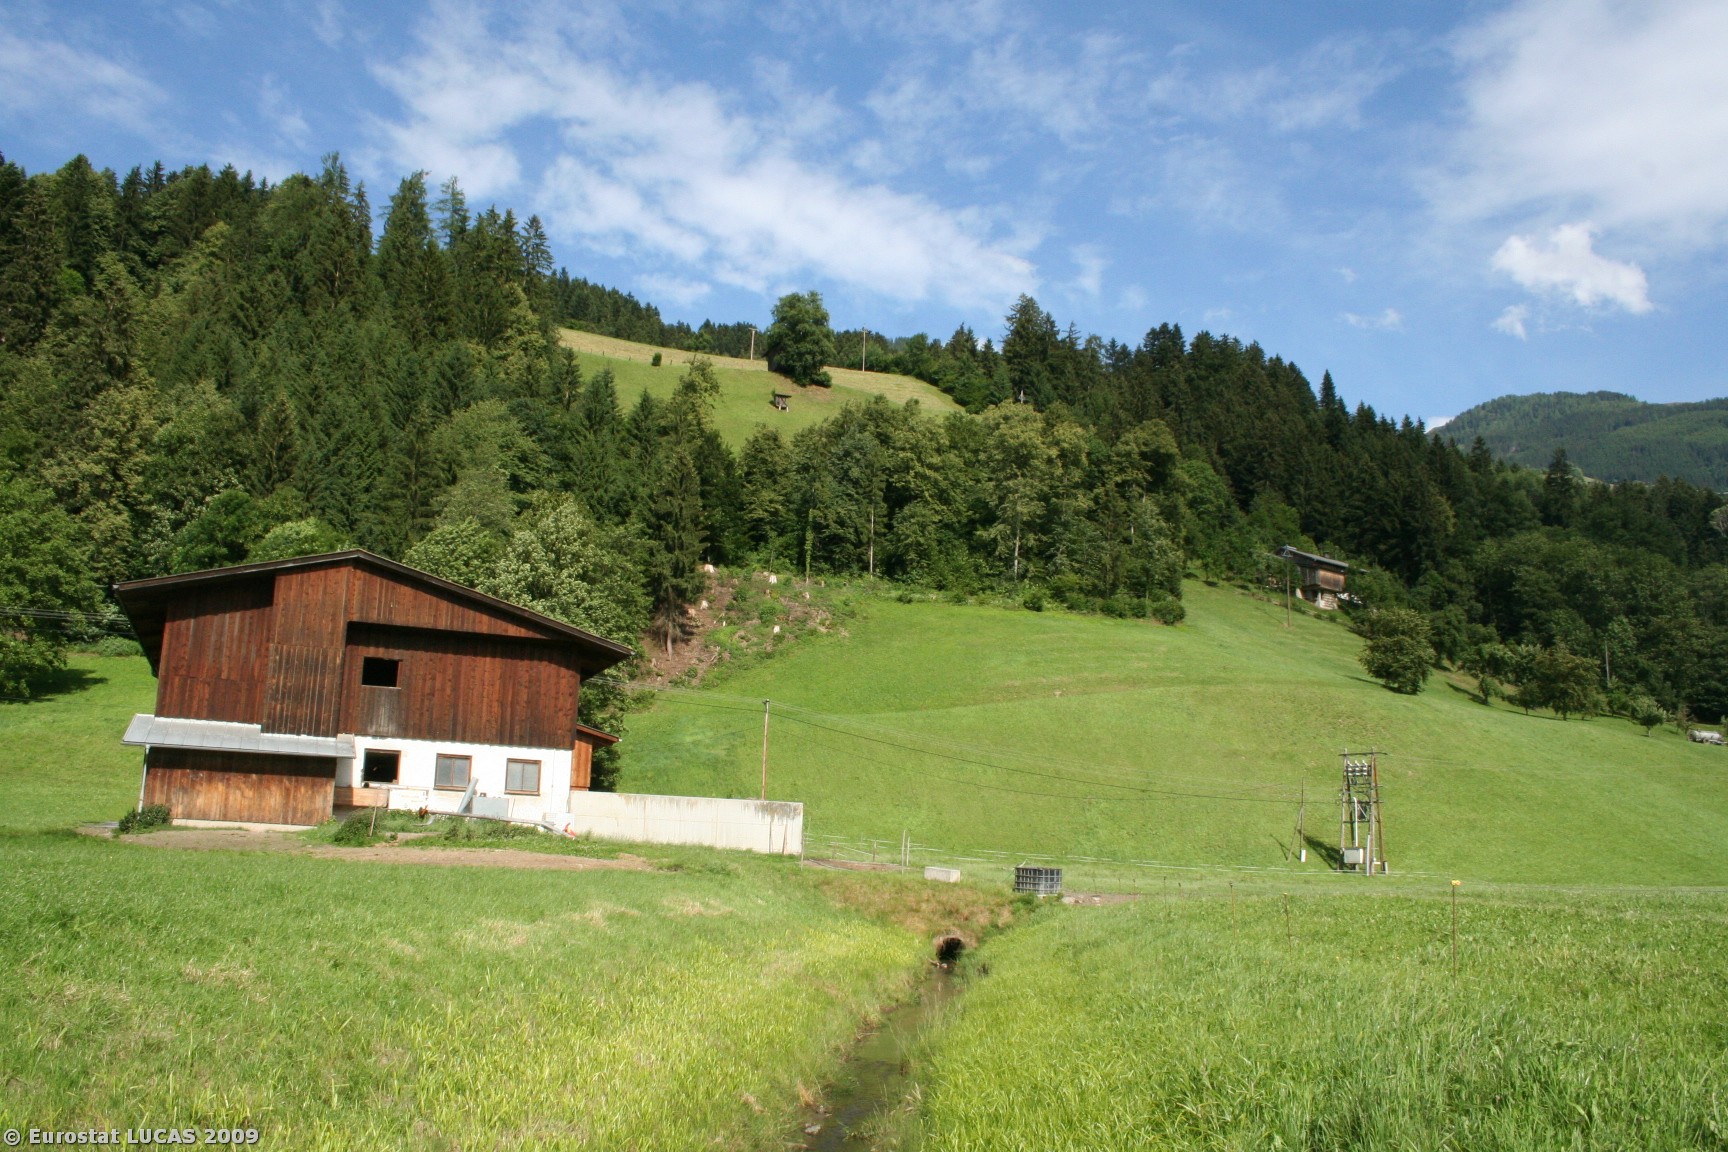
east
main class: Grassland
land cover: Grassland without tree/shrub cover
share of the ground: > 75 %
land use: Agriculture (excluding fallow land and kitchen gardens)
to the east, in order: Grassland without tree/shrub cover; Rivers and streams; Grassland without tree/shrub cover; Artificial constructions in urban areas; Grassland without tree/shrub cover; Shrubland without tree cover; Mixed woodland; Tracks; Grassland without tree/shrub cover; Tracks; Grassland without tree/shrub cover
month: June
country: AT
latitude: 47.3616
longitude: 11.8654
